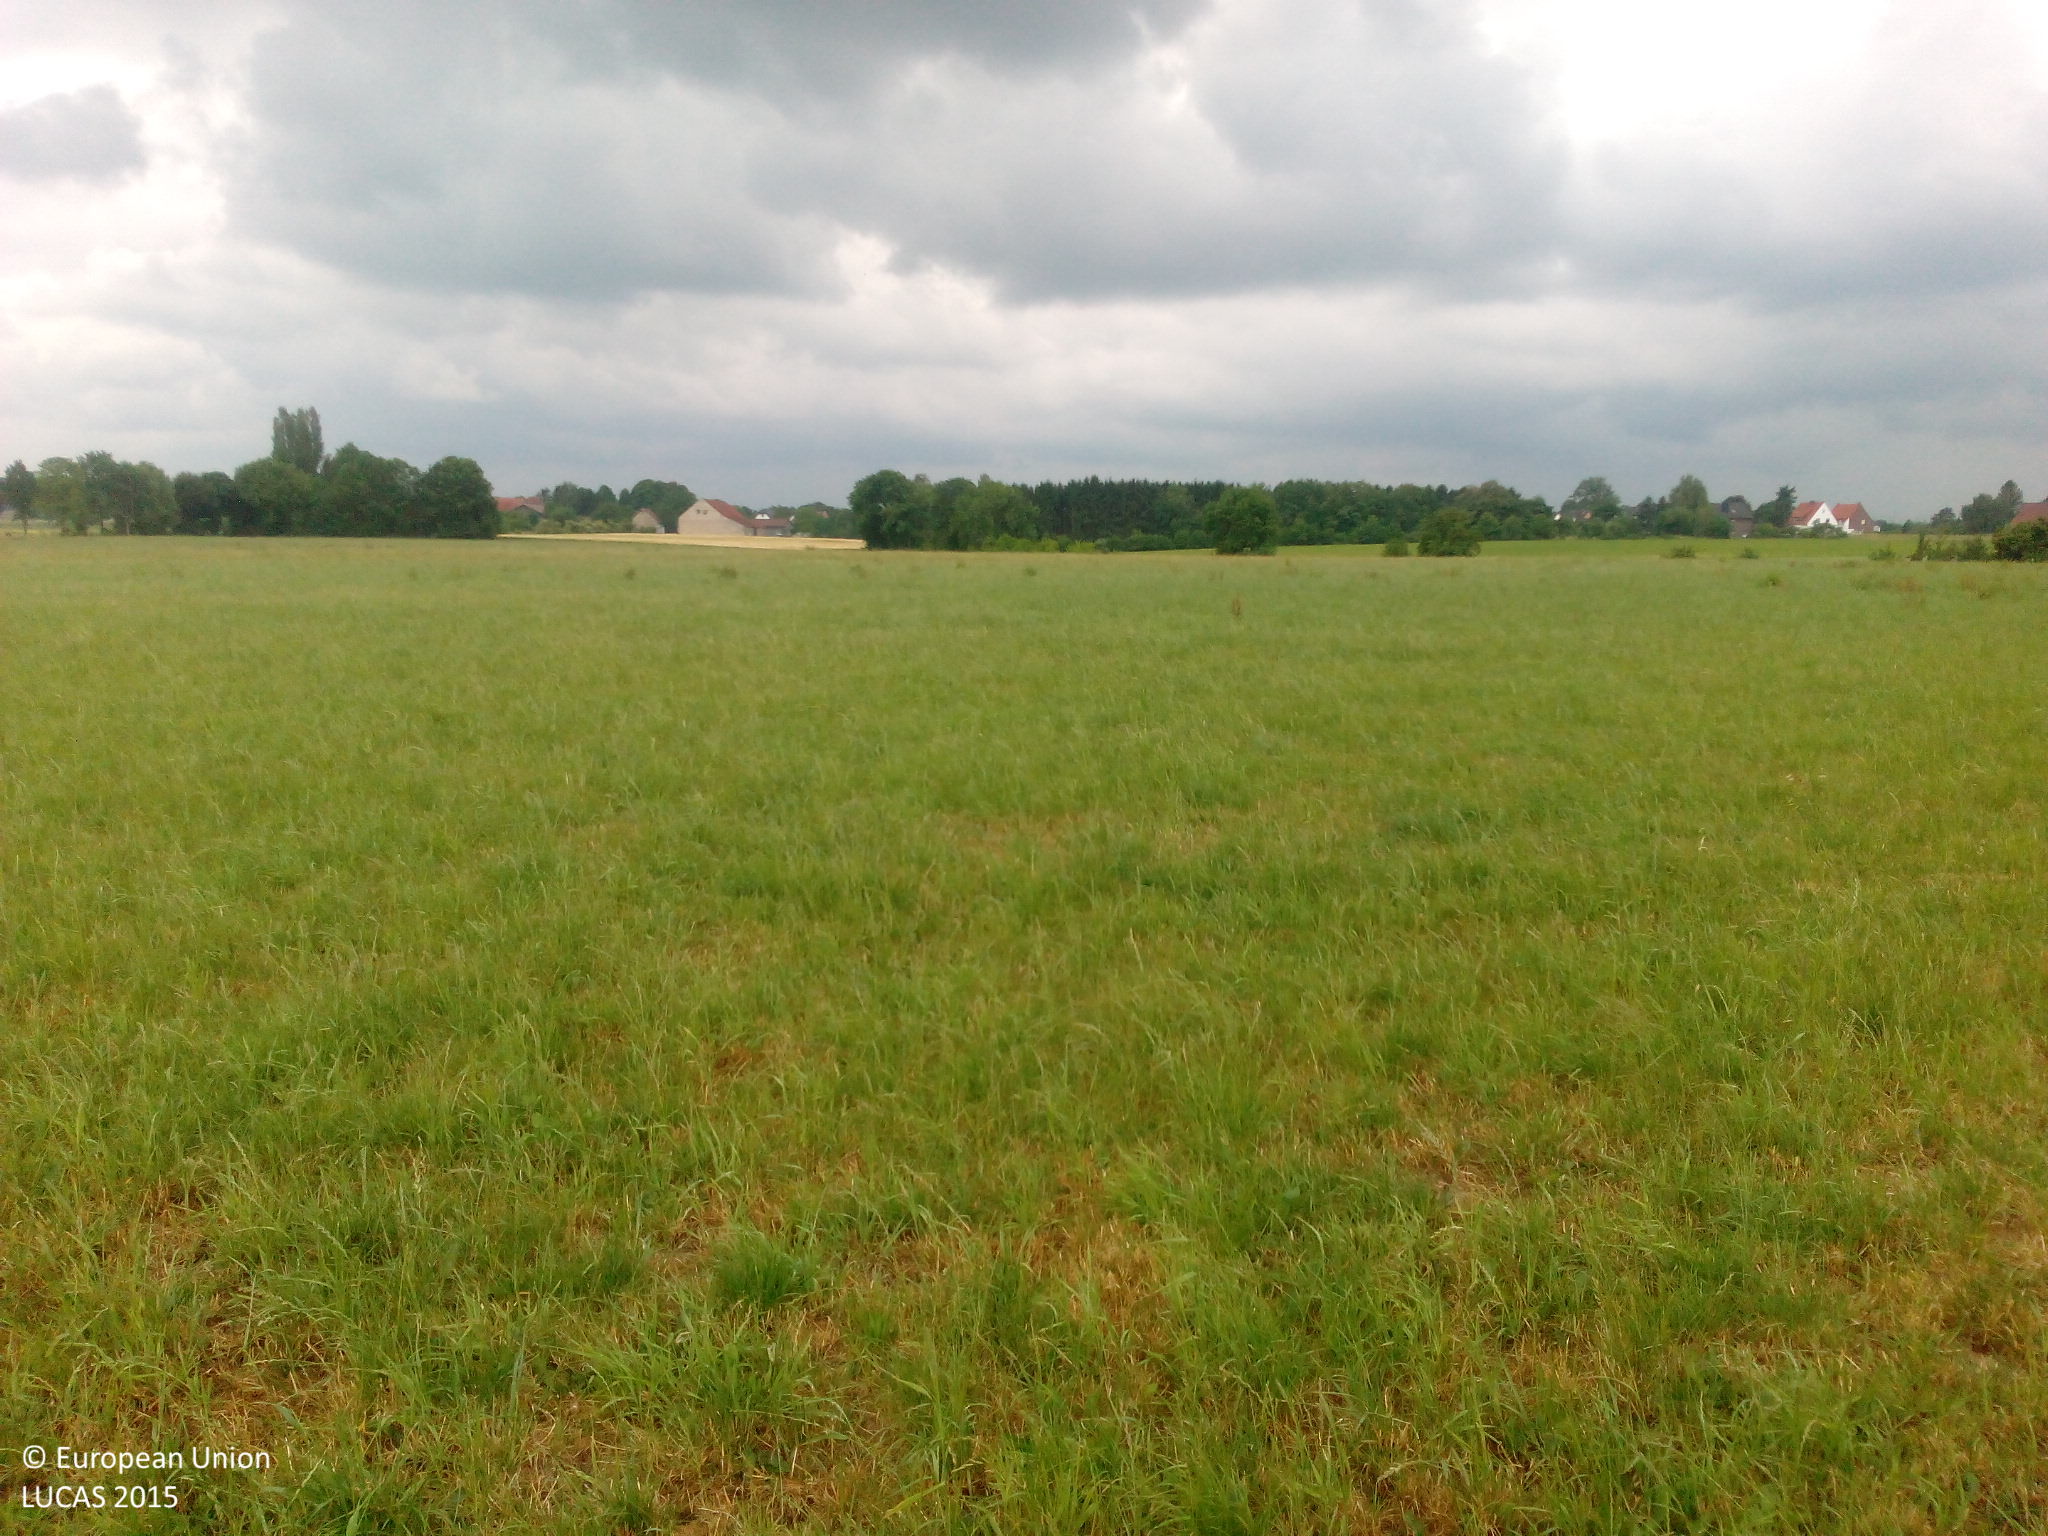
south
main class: Grassland
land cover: Grassland without tree/shrub cover
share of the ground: > 75 %
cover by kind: herbaceous plants 100 %
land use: Agriculture (excluding fallow land and kitchen gardens)
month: June
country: DE
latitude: 51.5760
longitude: 8.4276
